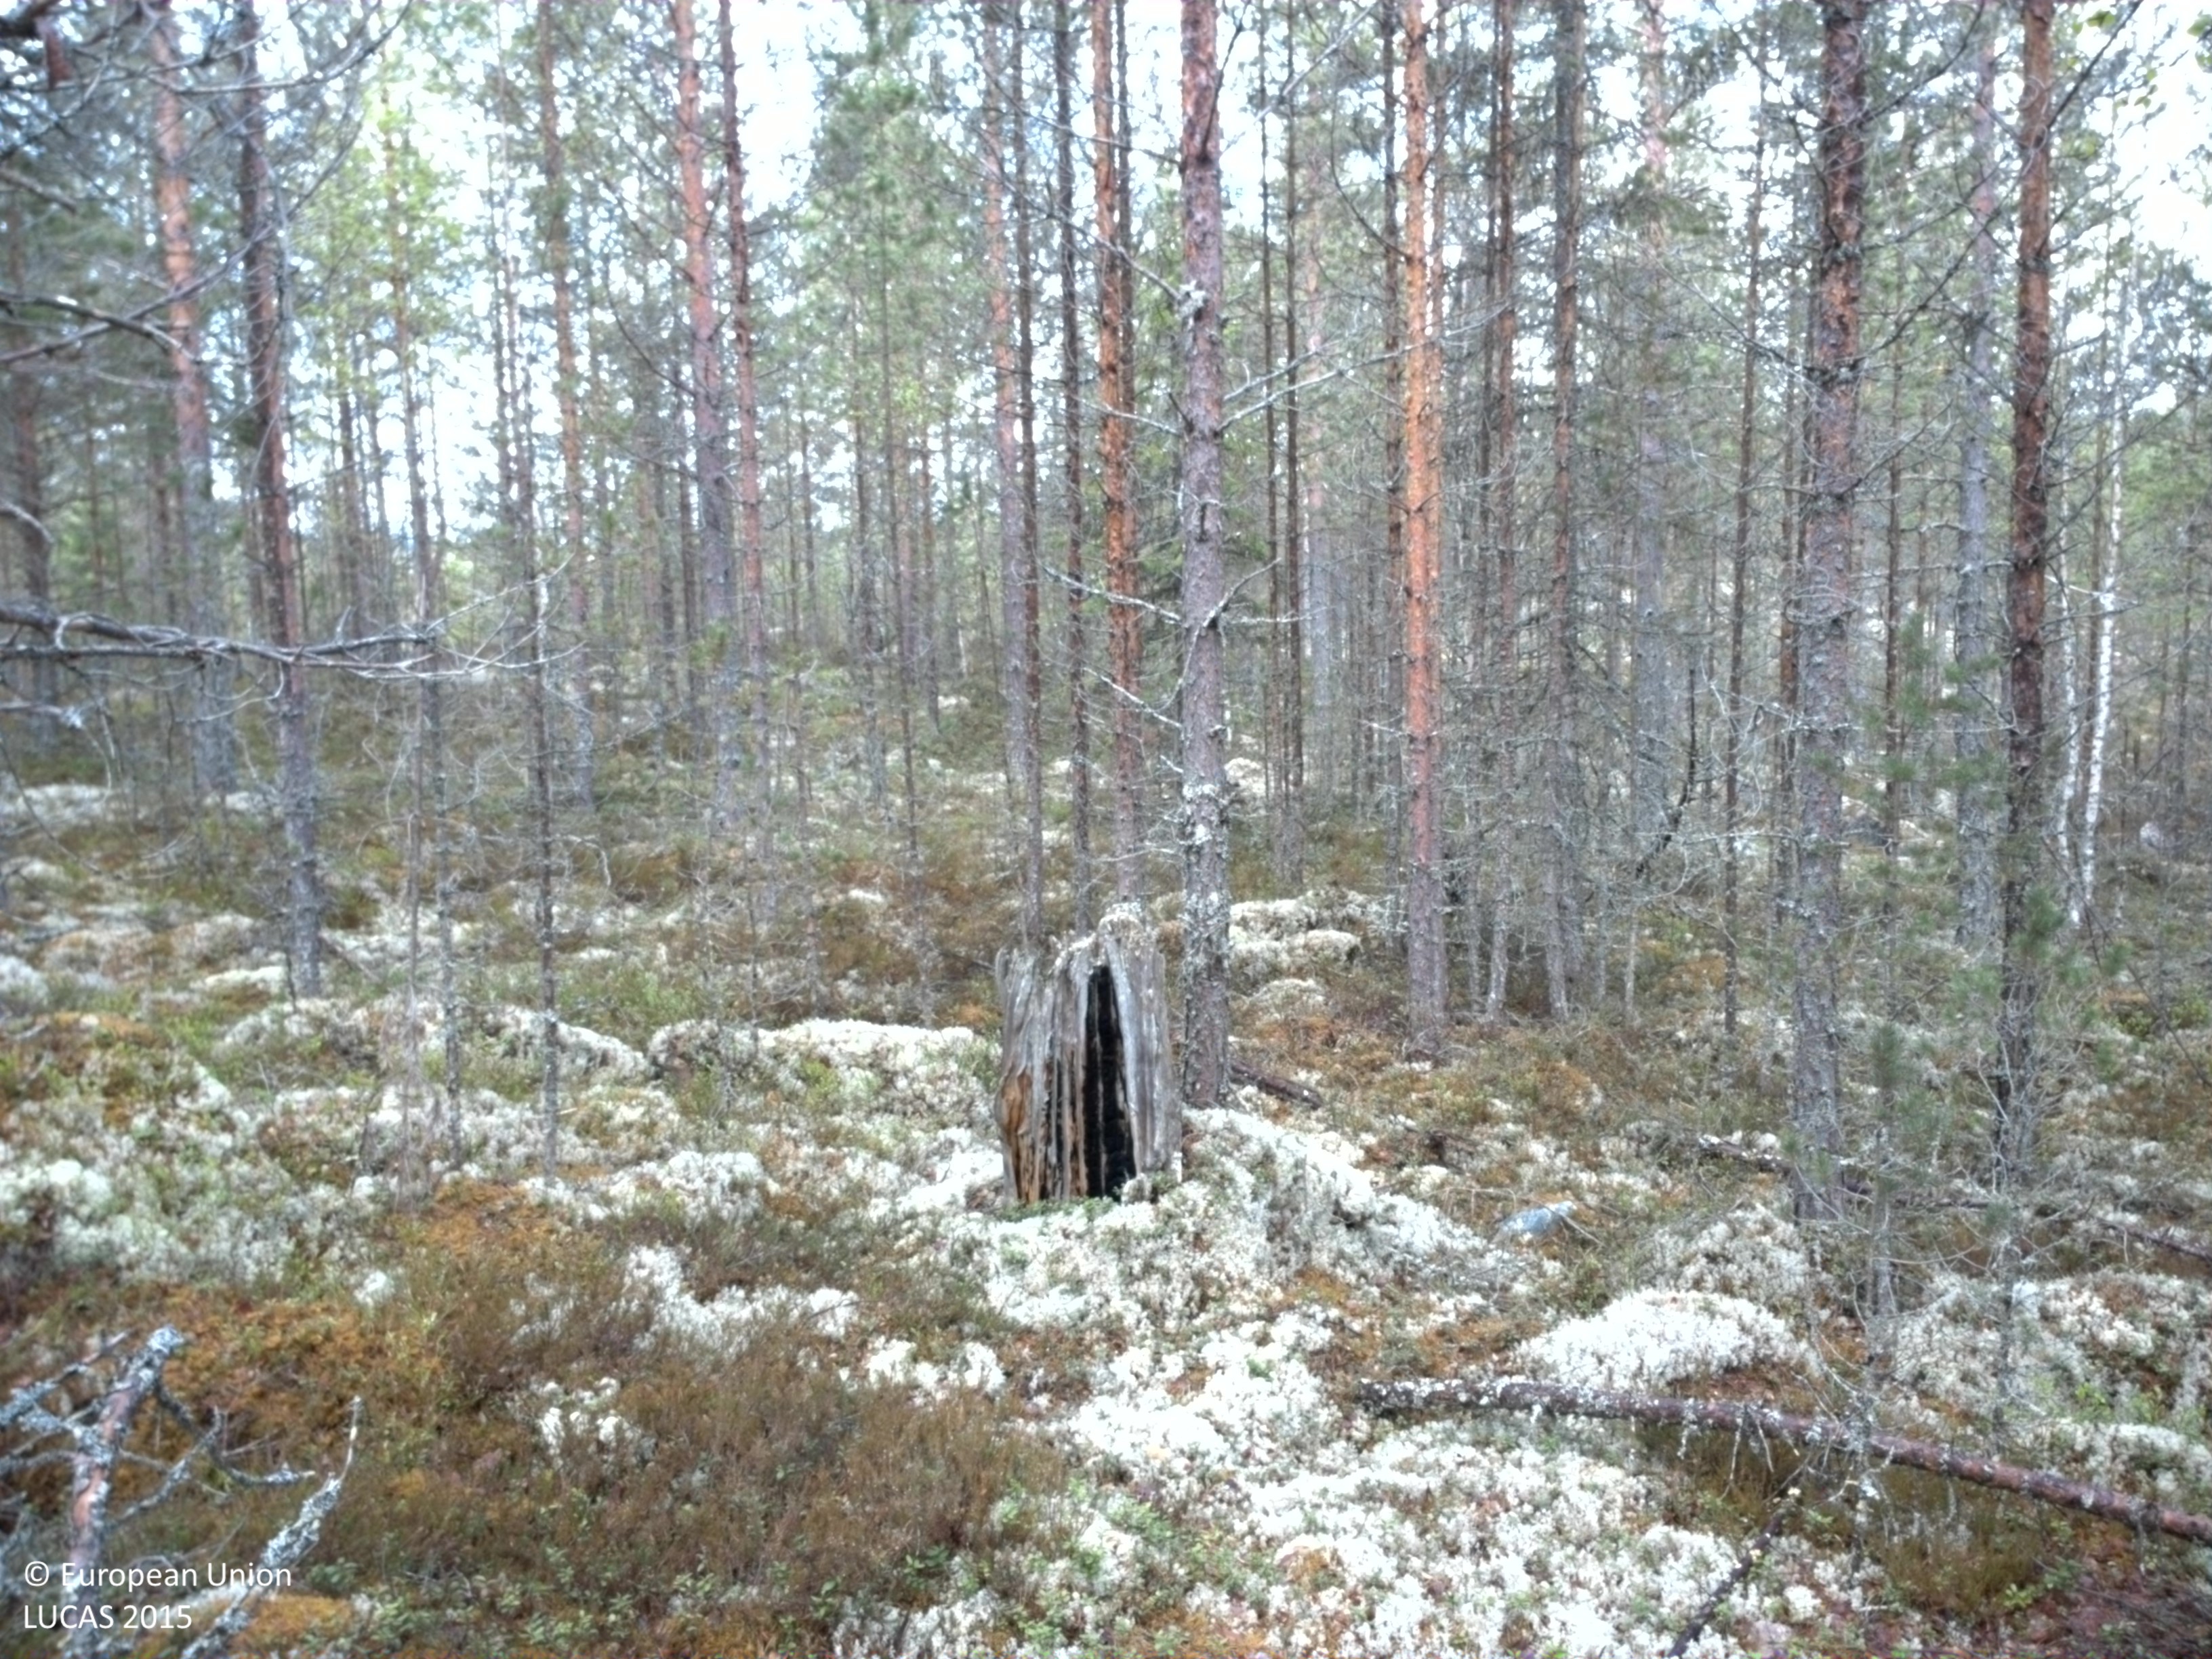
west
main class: Woodland
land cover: Pine dominated coniferous woodland
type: boreal forest
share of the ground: 50 - 75 %
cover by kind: coniferous forest trees 65 %, herbaceous plants 30 %, lichens and mosses 5 %
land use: Forestry
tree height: > 5 m
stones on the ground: < 10 %
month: May
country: SE
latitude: 61.2132
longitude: 15.4395
